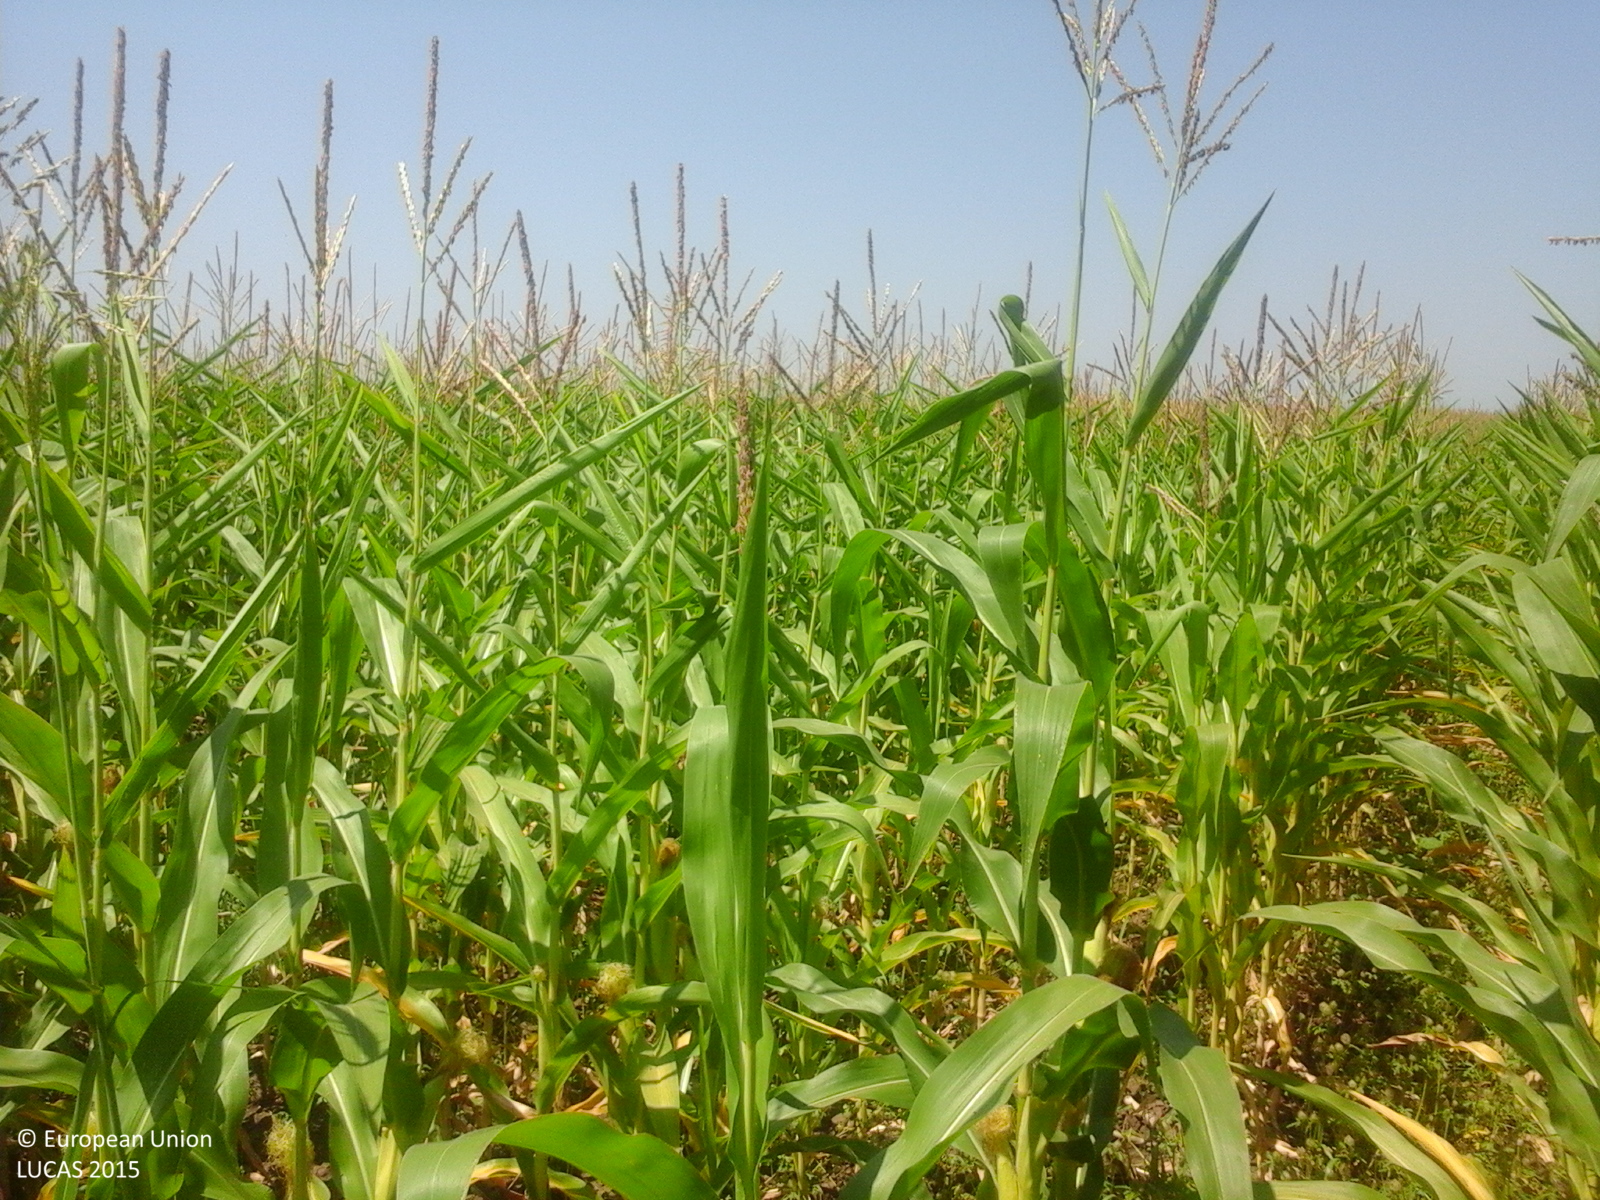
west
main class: Cropland
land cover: Maize
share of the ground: > 75 %
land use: Agriculture (excluding fallow land and kitchen gardens)
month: July
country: RO
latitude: 44.7548
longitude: 26.7876
